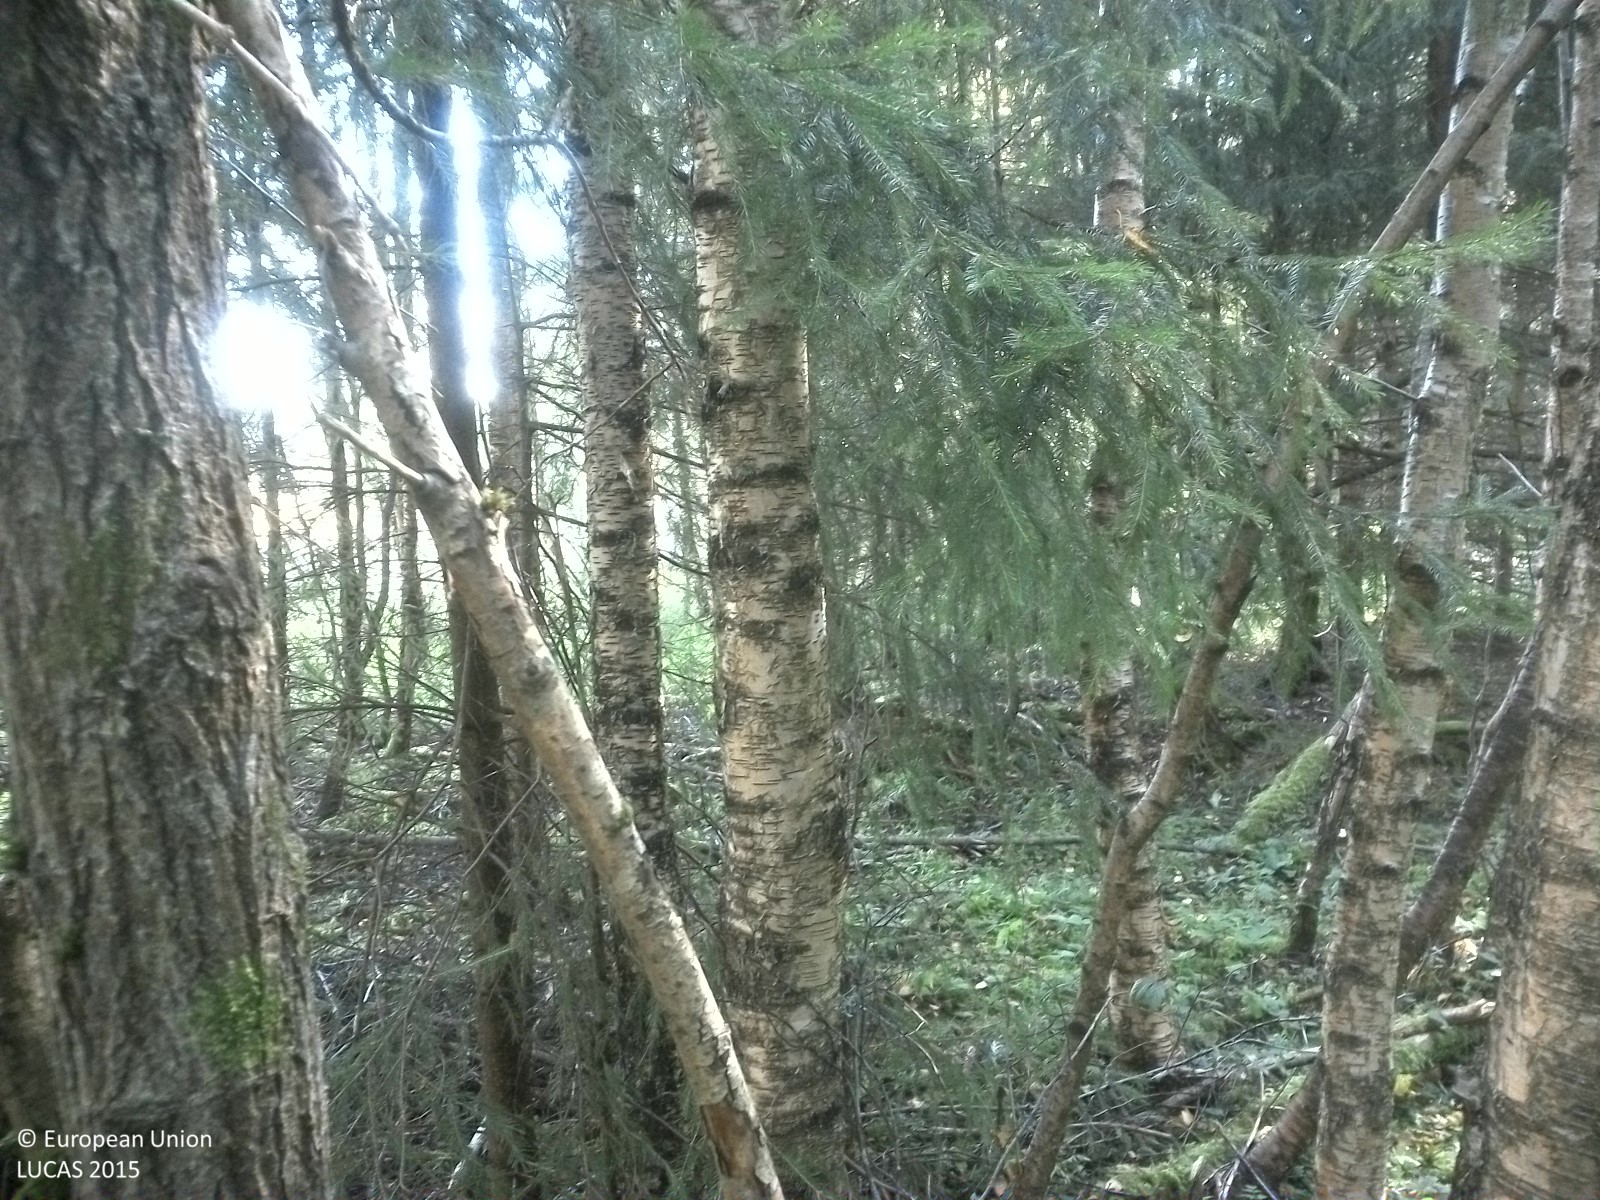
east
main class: Woodland
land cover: Spruce dominated mixed woodland
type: boreal forest
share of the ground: 50 - 75 %
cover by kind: herbaceous plants 35 %, coniferous forest trees 30 %, broadleaved forest trees 20 %, unconsolidated bare surface 10 %, lichens and mosses 5 %
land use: Forestry
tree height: > 5 m
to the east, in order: Spruce dominated mixed woodland; Ditches and canals; Fences; Grassland without tree/shrub cover; Fences; Spruce dominated mixed woodland; Other mixed woodland; Dry stone walls; Grassland without tree/shrub cover
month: September
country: SE
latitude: 58.9732
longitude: 15.0192
